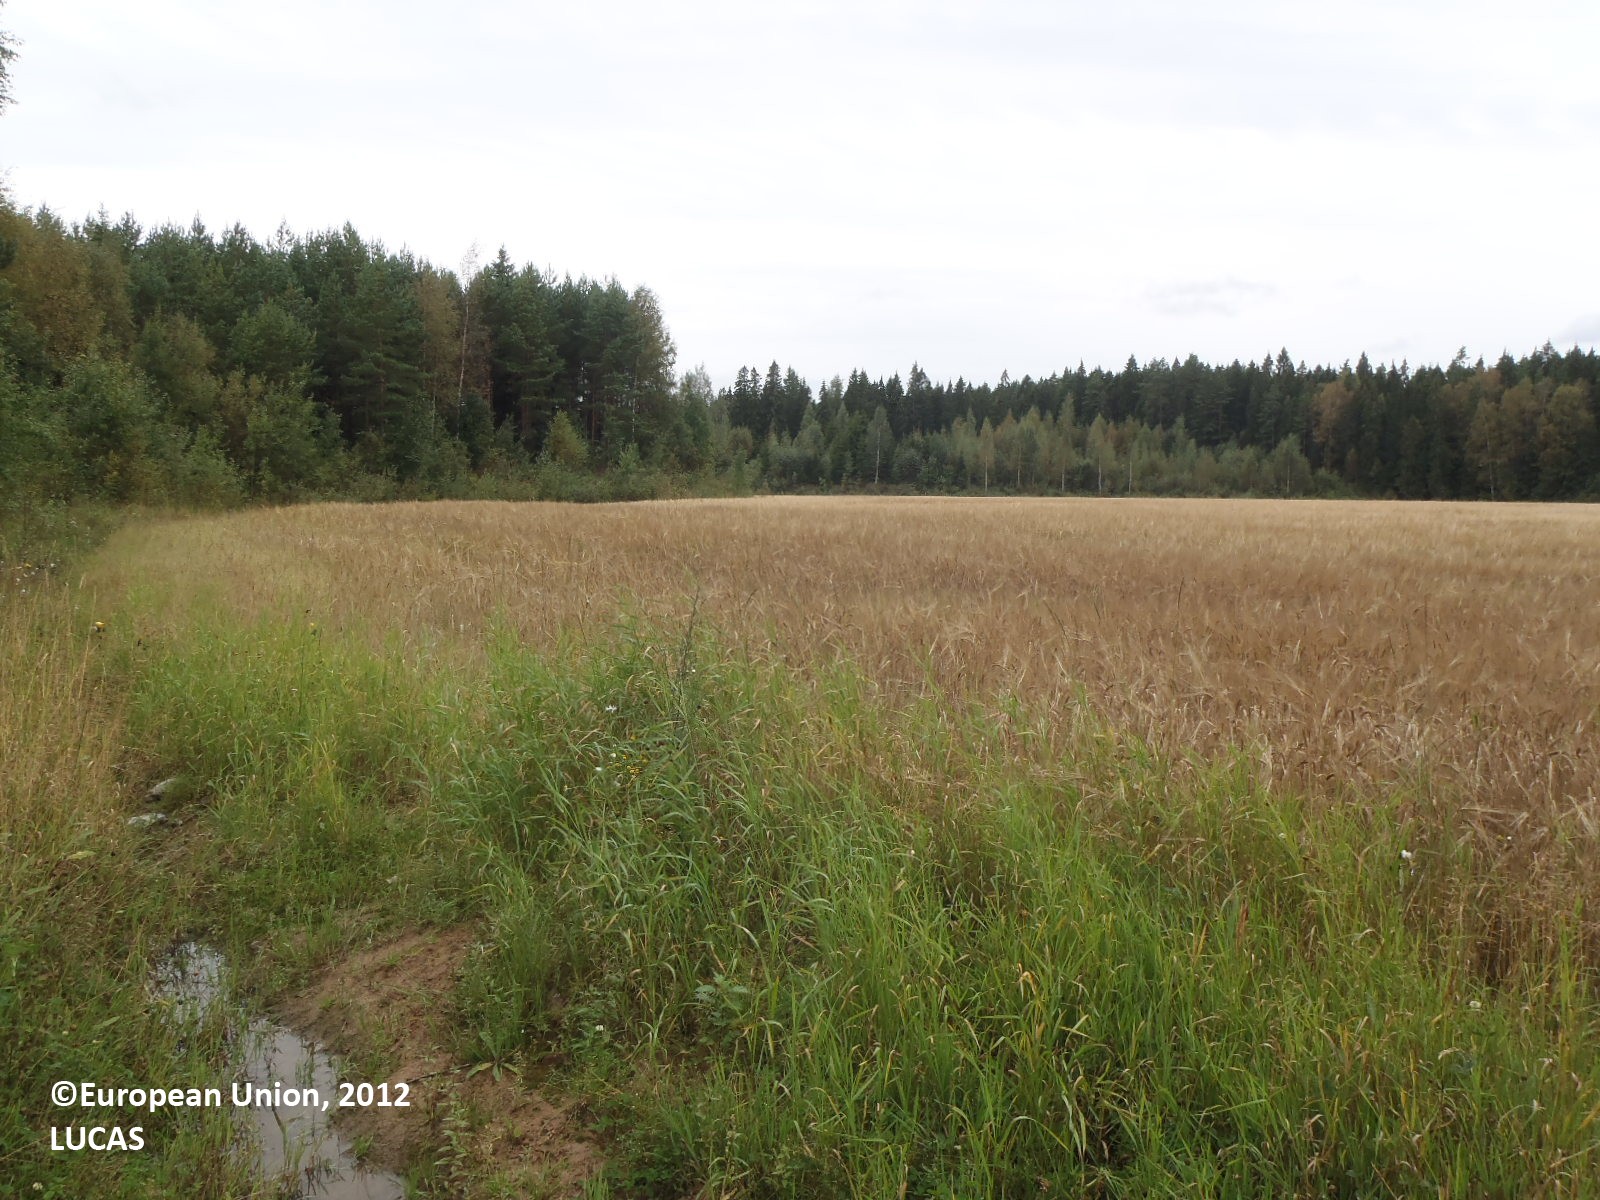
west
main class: Cropland
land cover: Barley
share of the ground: > 75 %
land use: Agriculture (excluding fallow land and kitchen gardens)
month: September
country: FI
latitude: 61.1401
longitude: 22.2649
